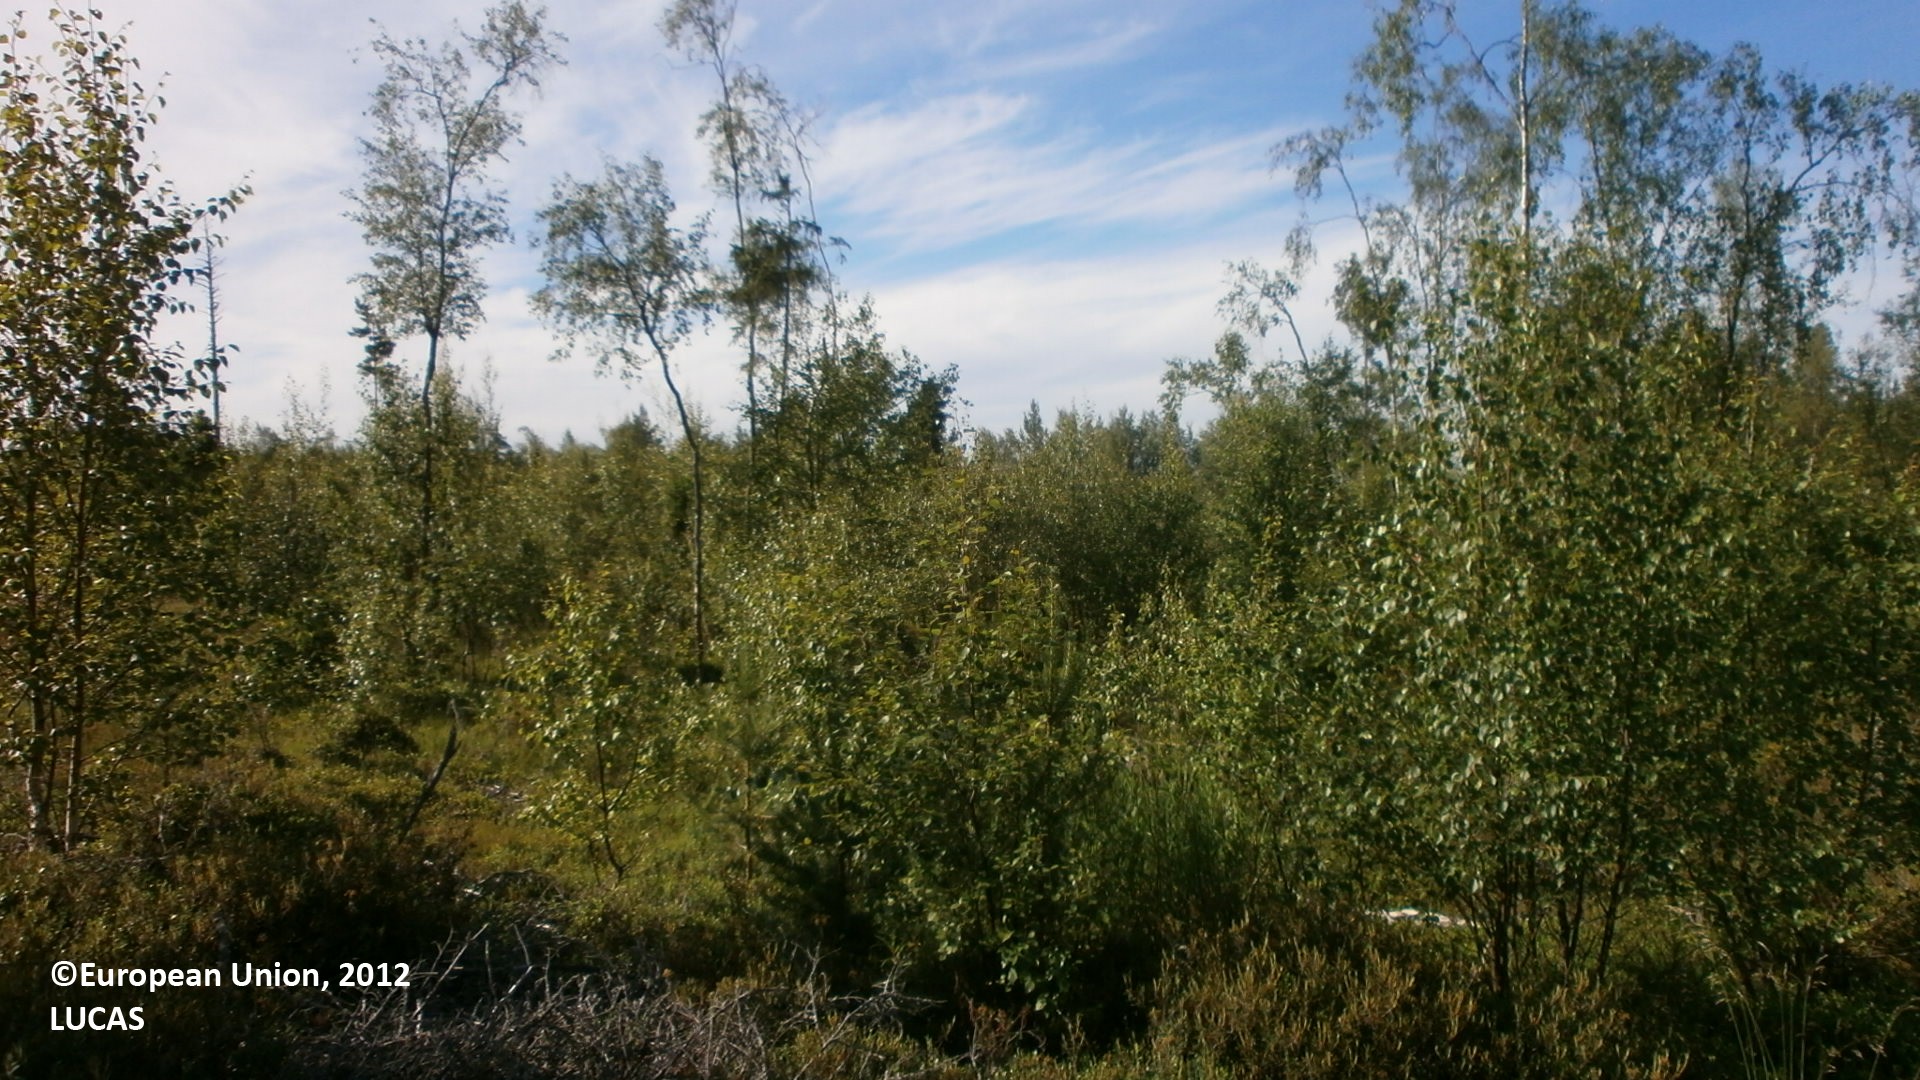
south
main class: Woodland
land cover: Pine dominated mixed woodland
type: boreal forest
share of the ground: 10 - 25 %
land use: Forestry
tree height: > 5 m
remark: Clear cut
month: July
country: FI
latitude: 64.4395
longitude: 24.1683
